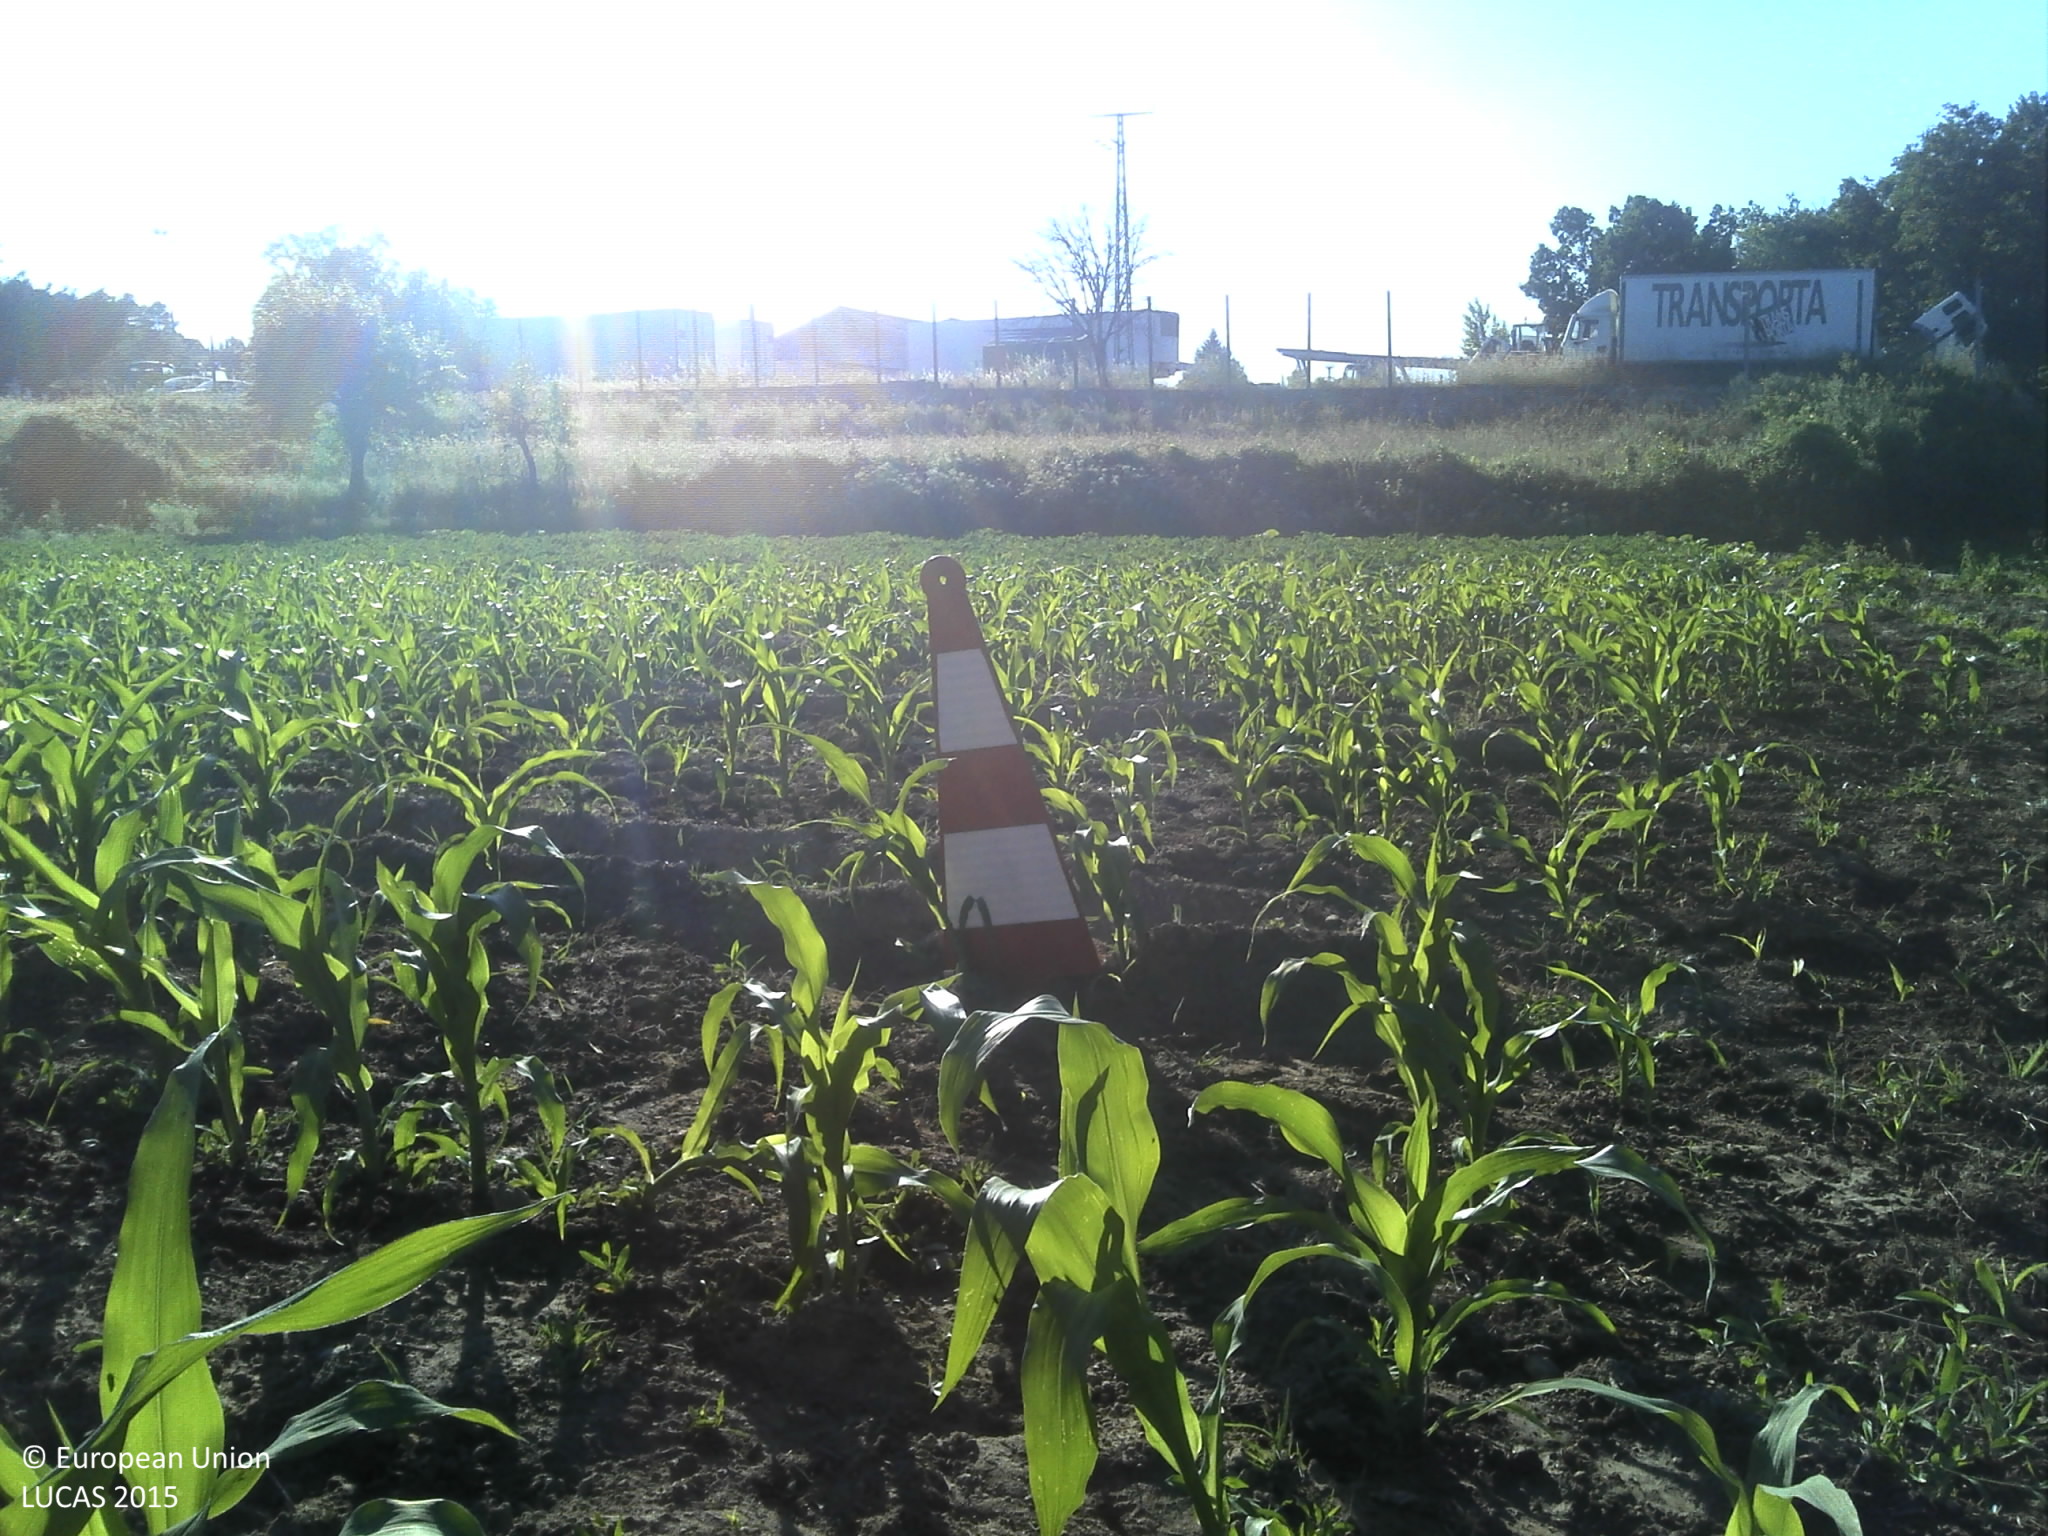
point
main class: Cropland
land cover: Maize
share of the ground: 10 - 25 %
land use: Agriculture (excluding fallow land and kitchen gardens)
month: May
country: PT
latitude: 40.6162
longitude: -7.3065
